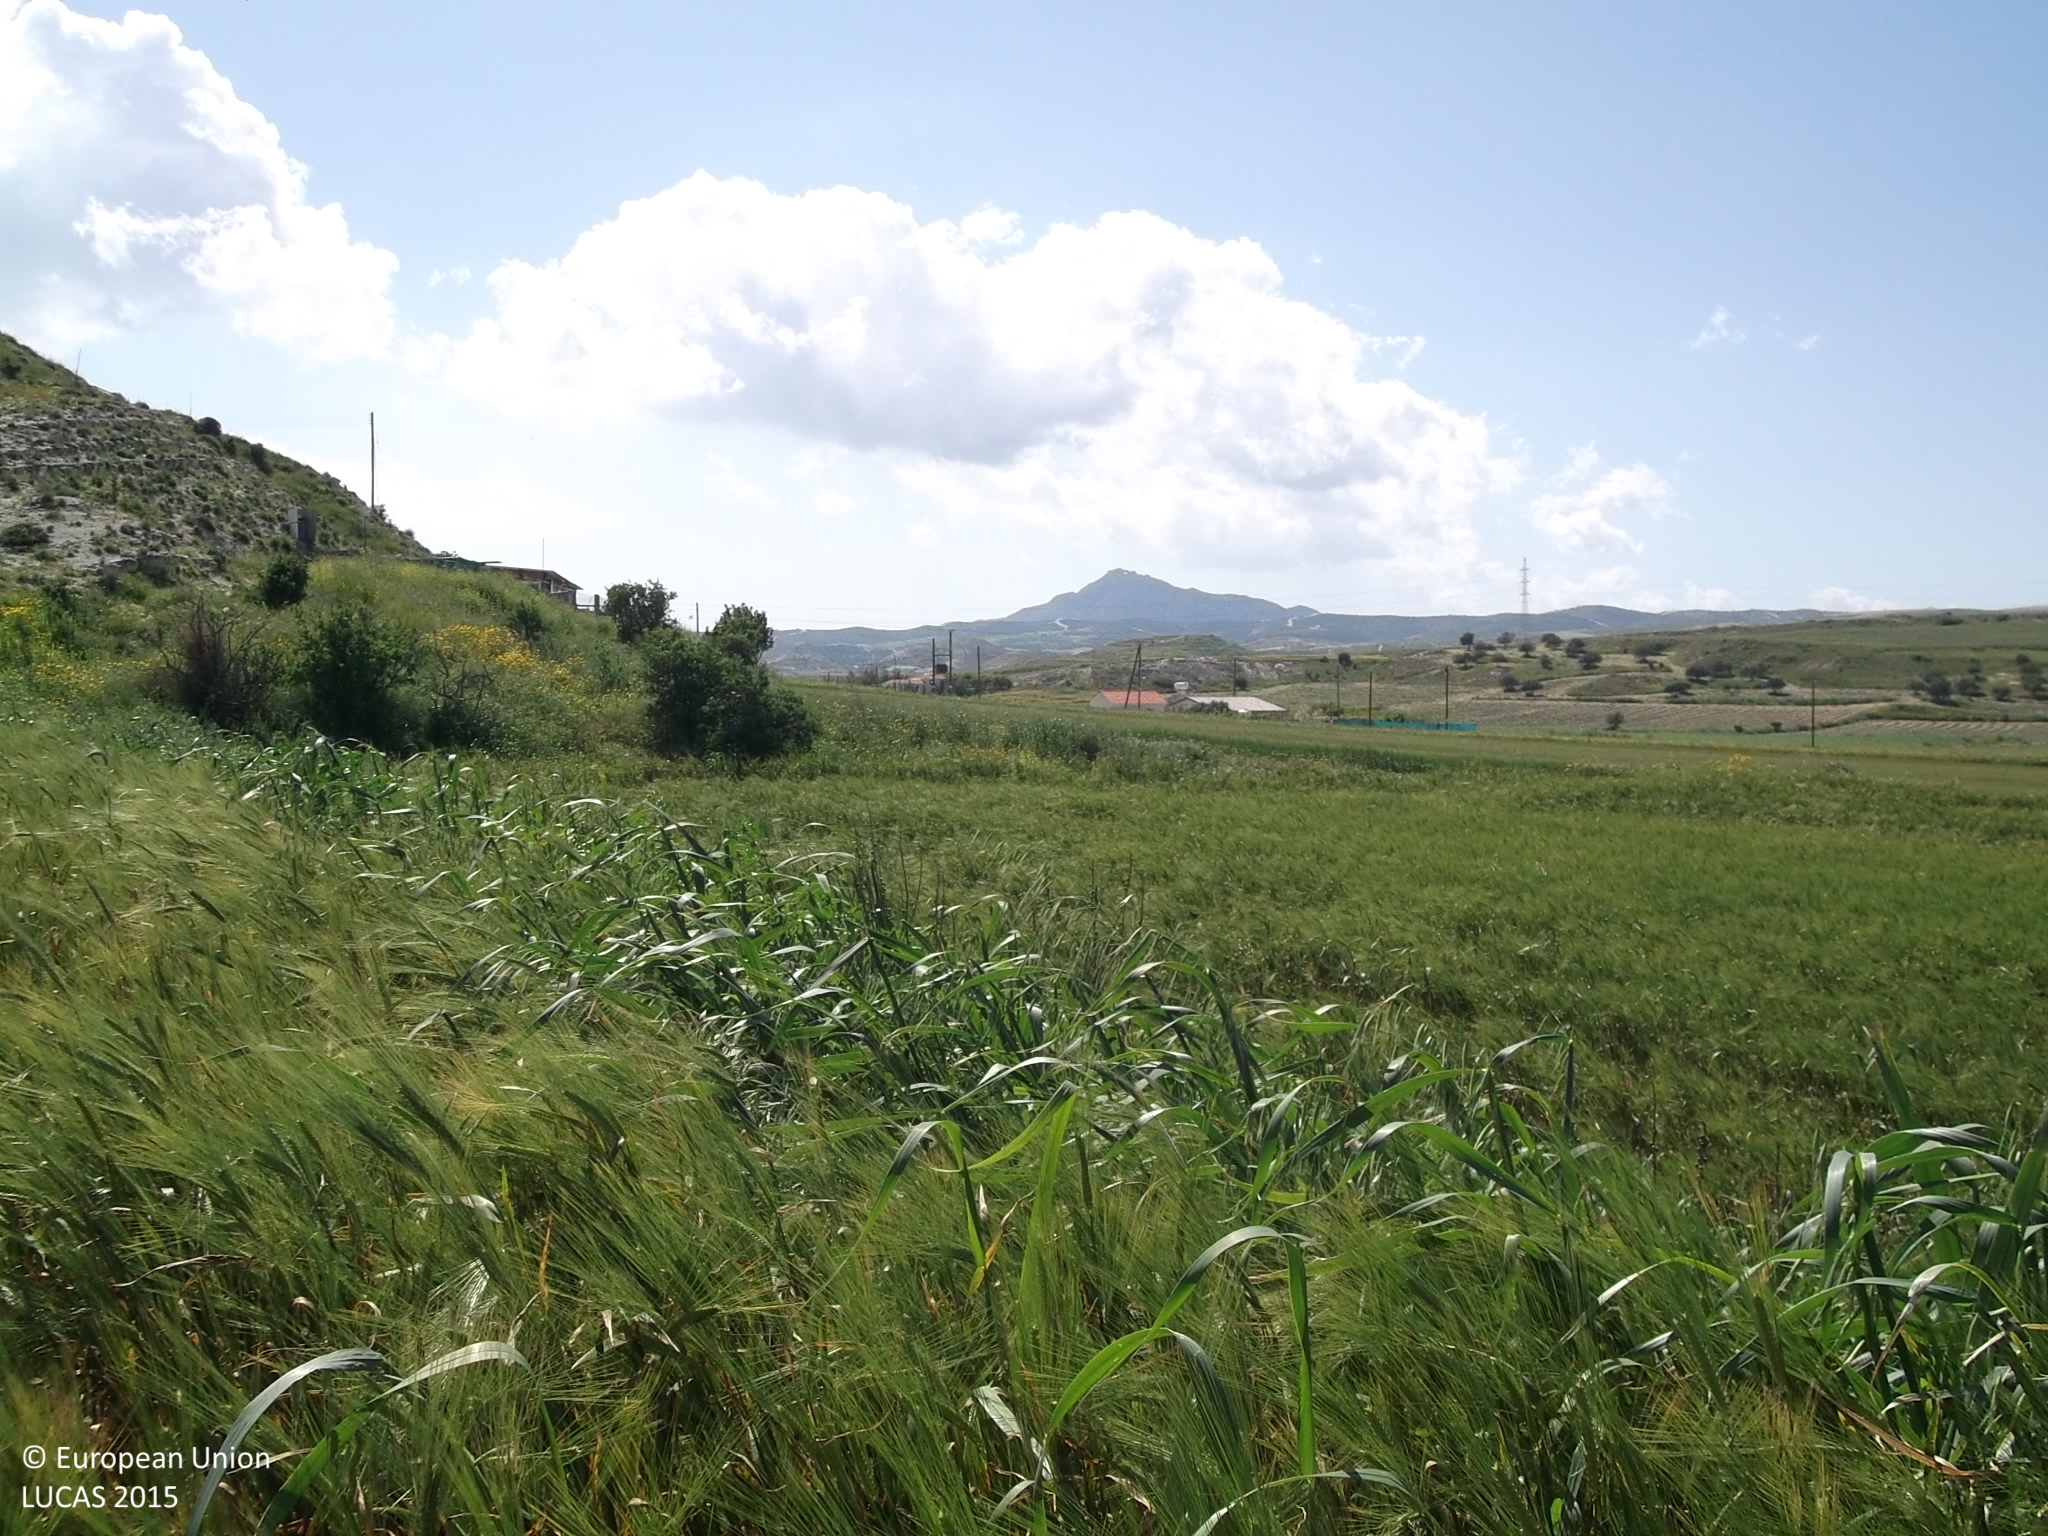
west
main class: Cropland
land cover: Mixed cereals for fodder
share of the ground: > 75 %
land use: Agriculture (excluding fallow land and kitchen gardens)
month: April
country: CY
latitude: 34.9170
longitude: 33.5399
